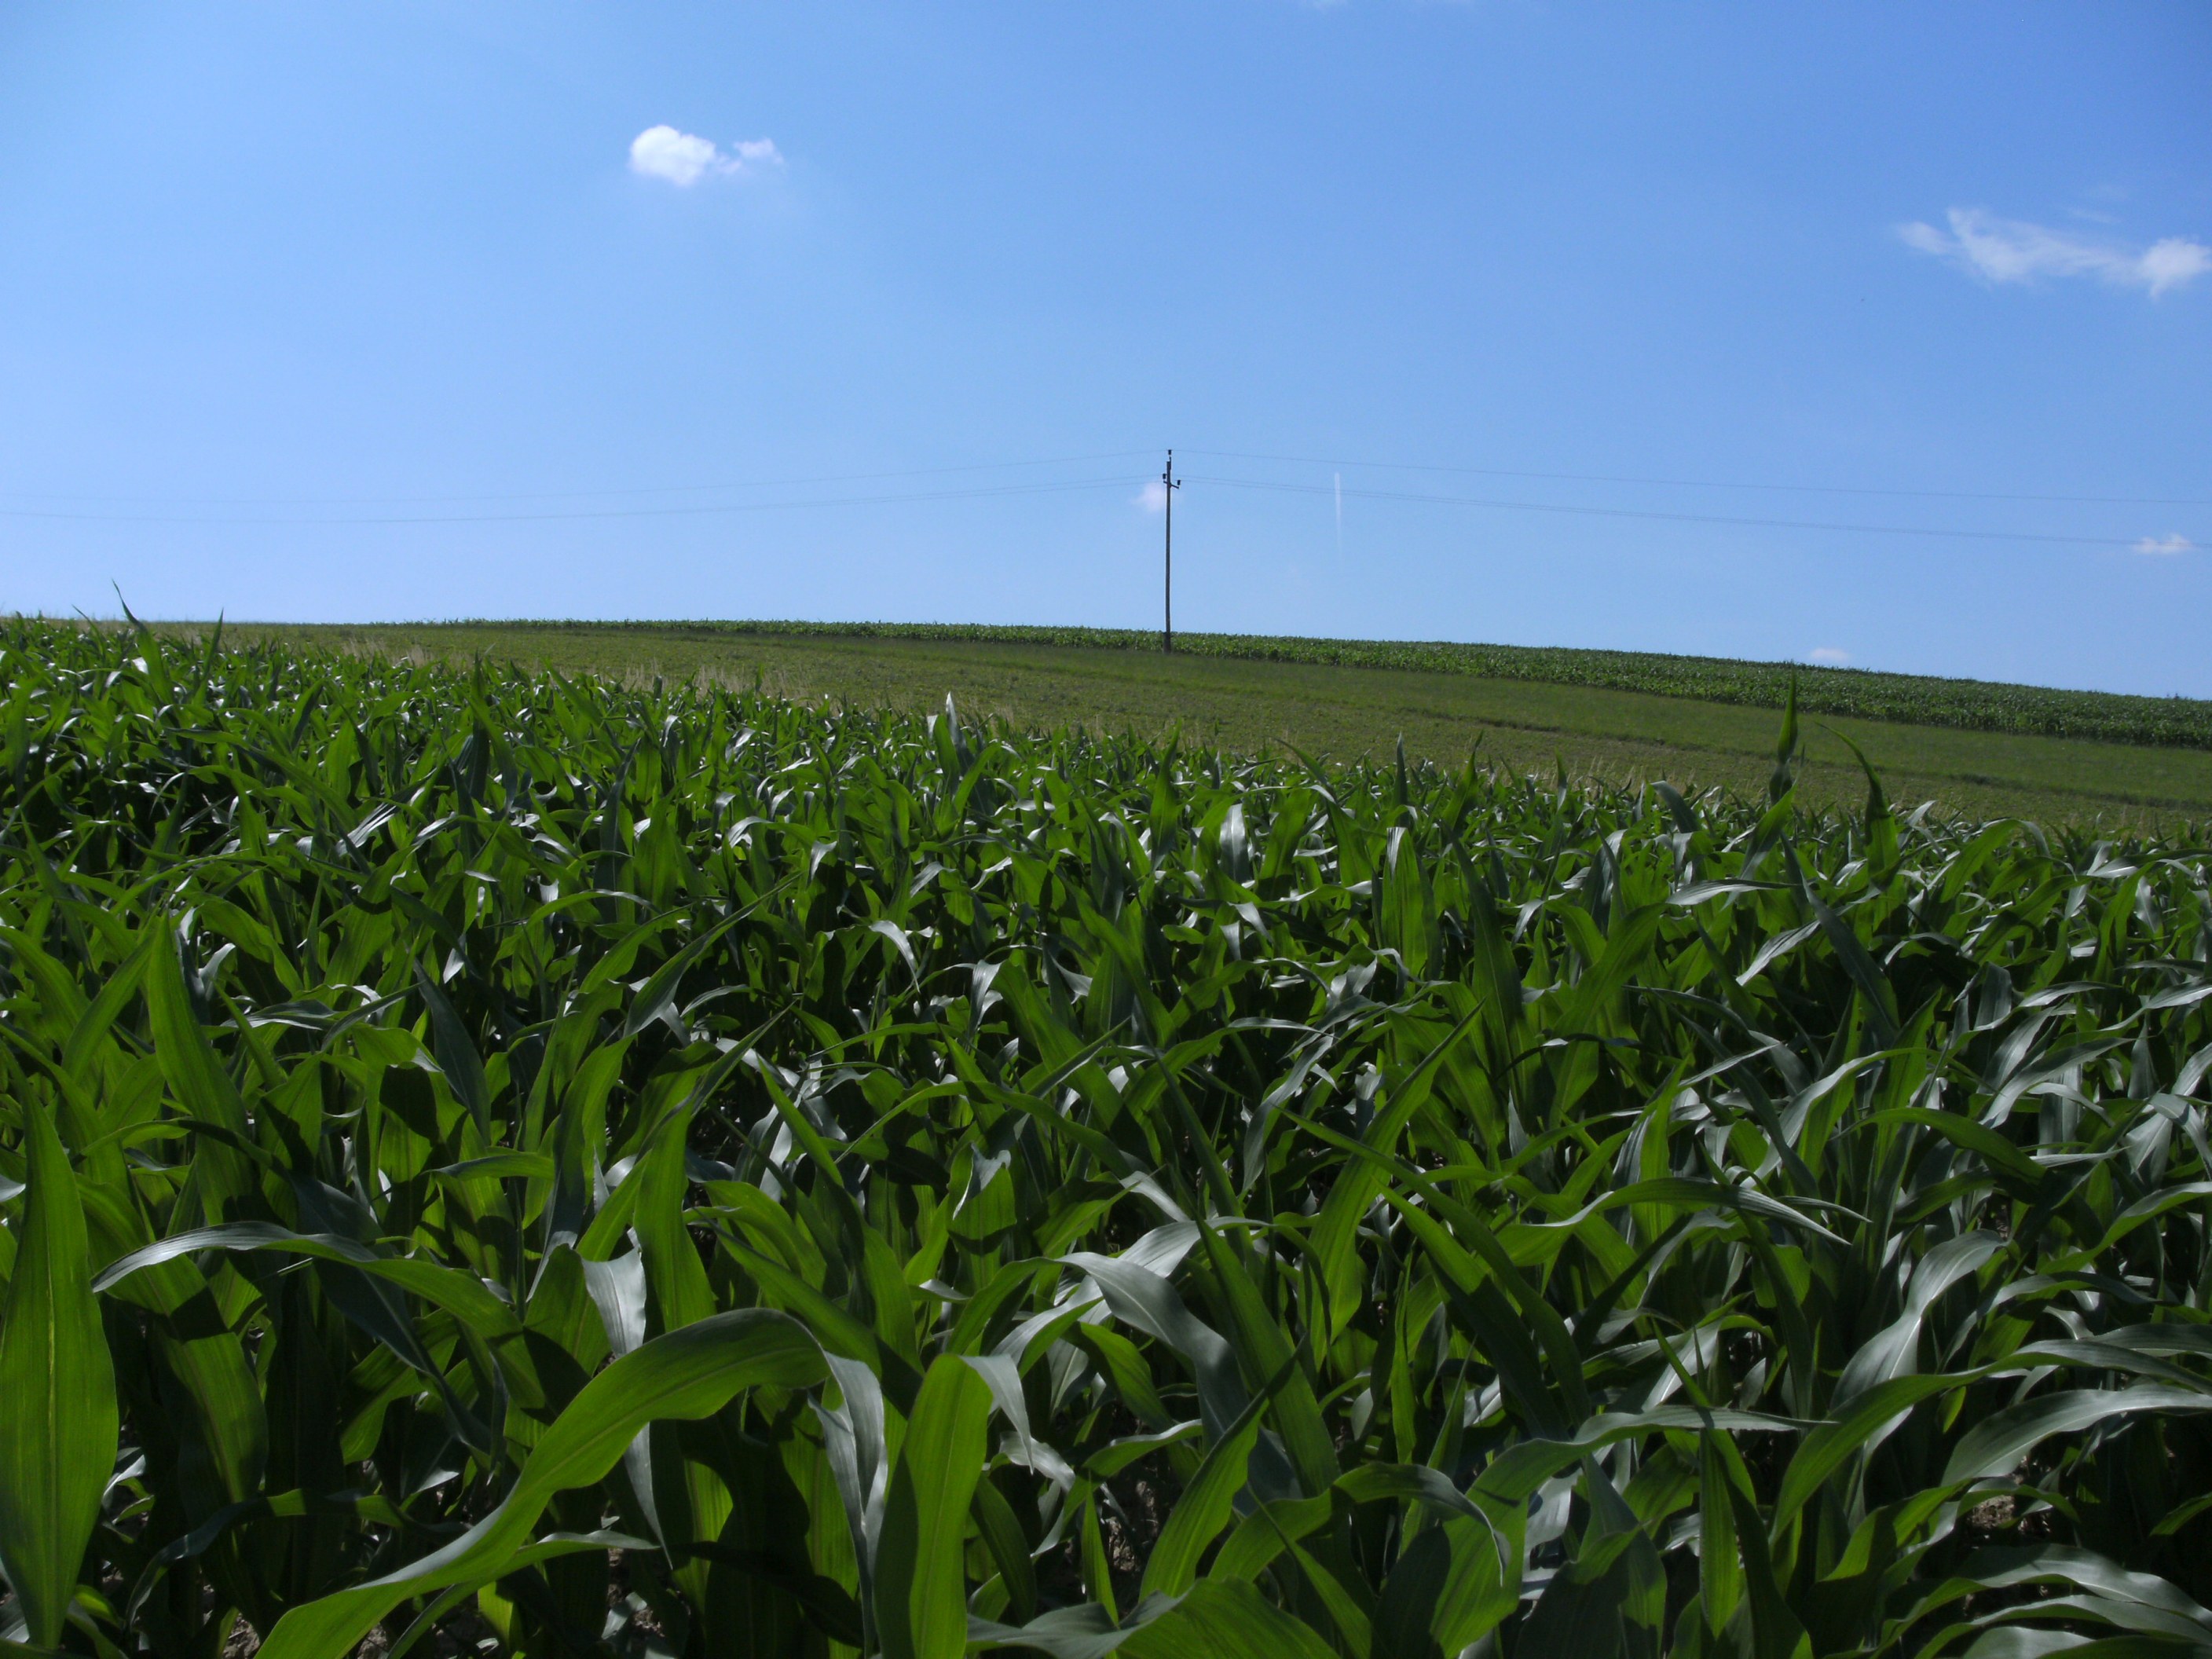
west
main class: Cropland
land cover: Maize
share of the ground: > 75 %
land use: Agriculture (excluding fallow land and kitchen gardens)
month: June
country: AT
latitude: 48.1948
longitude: 13.7798
